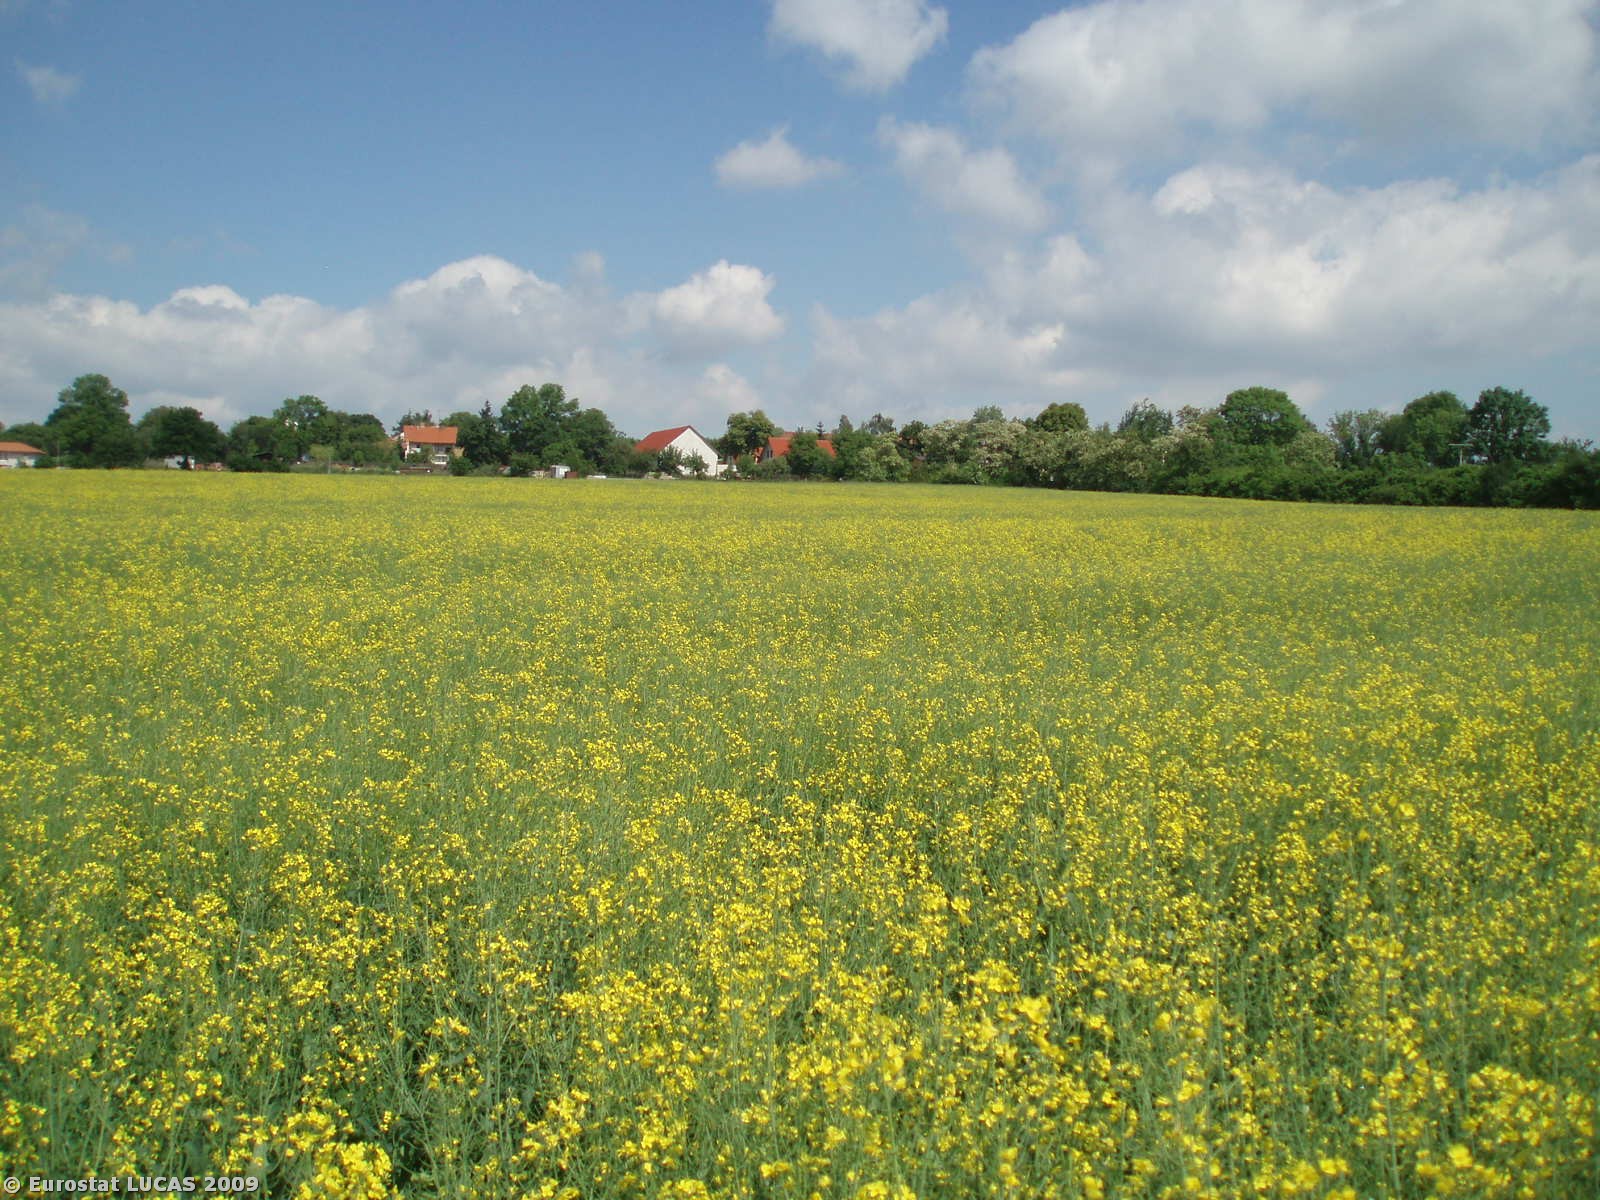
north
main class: Cropland
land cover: Rape and turnip rape
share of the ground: > 75 %
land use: Agriculture (excluding fallow land and kitchen gardens)
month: May
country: CZ
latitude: 50.0147
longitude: 14.2577
